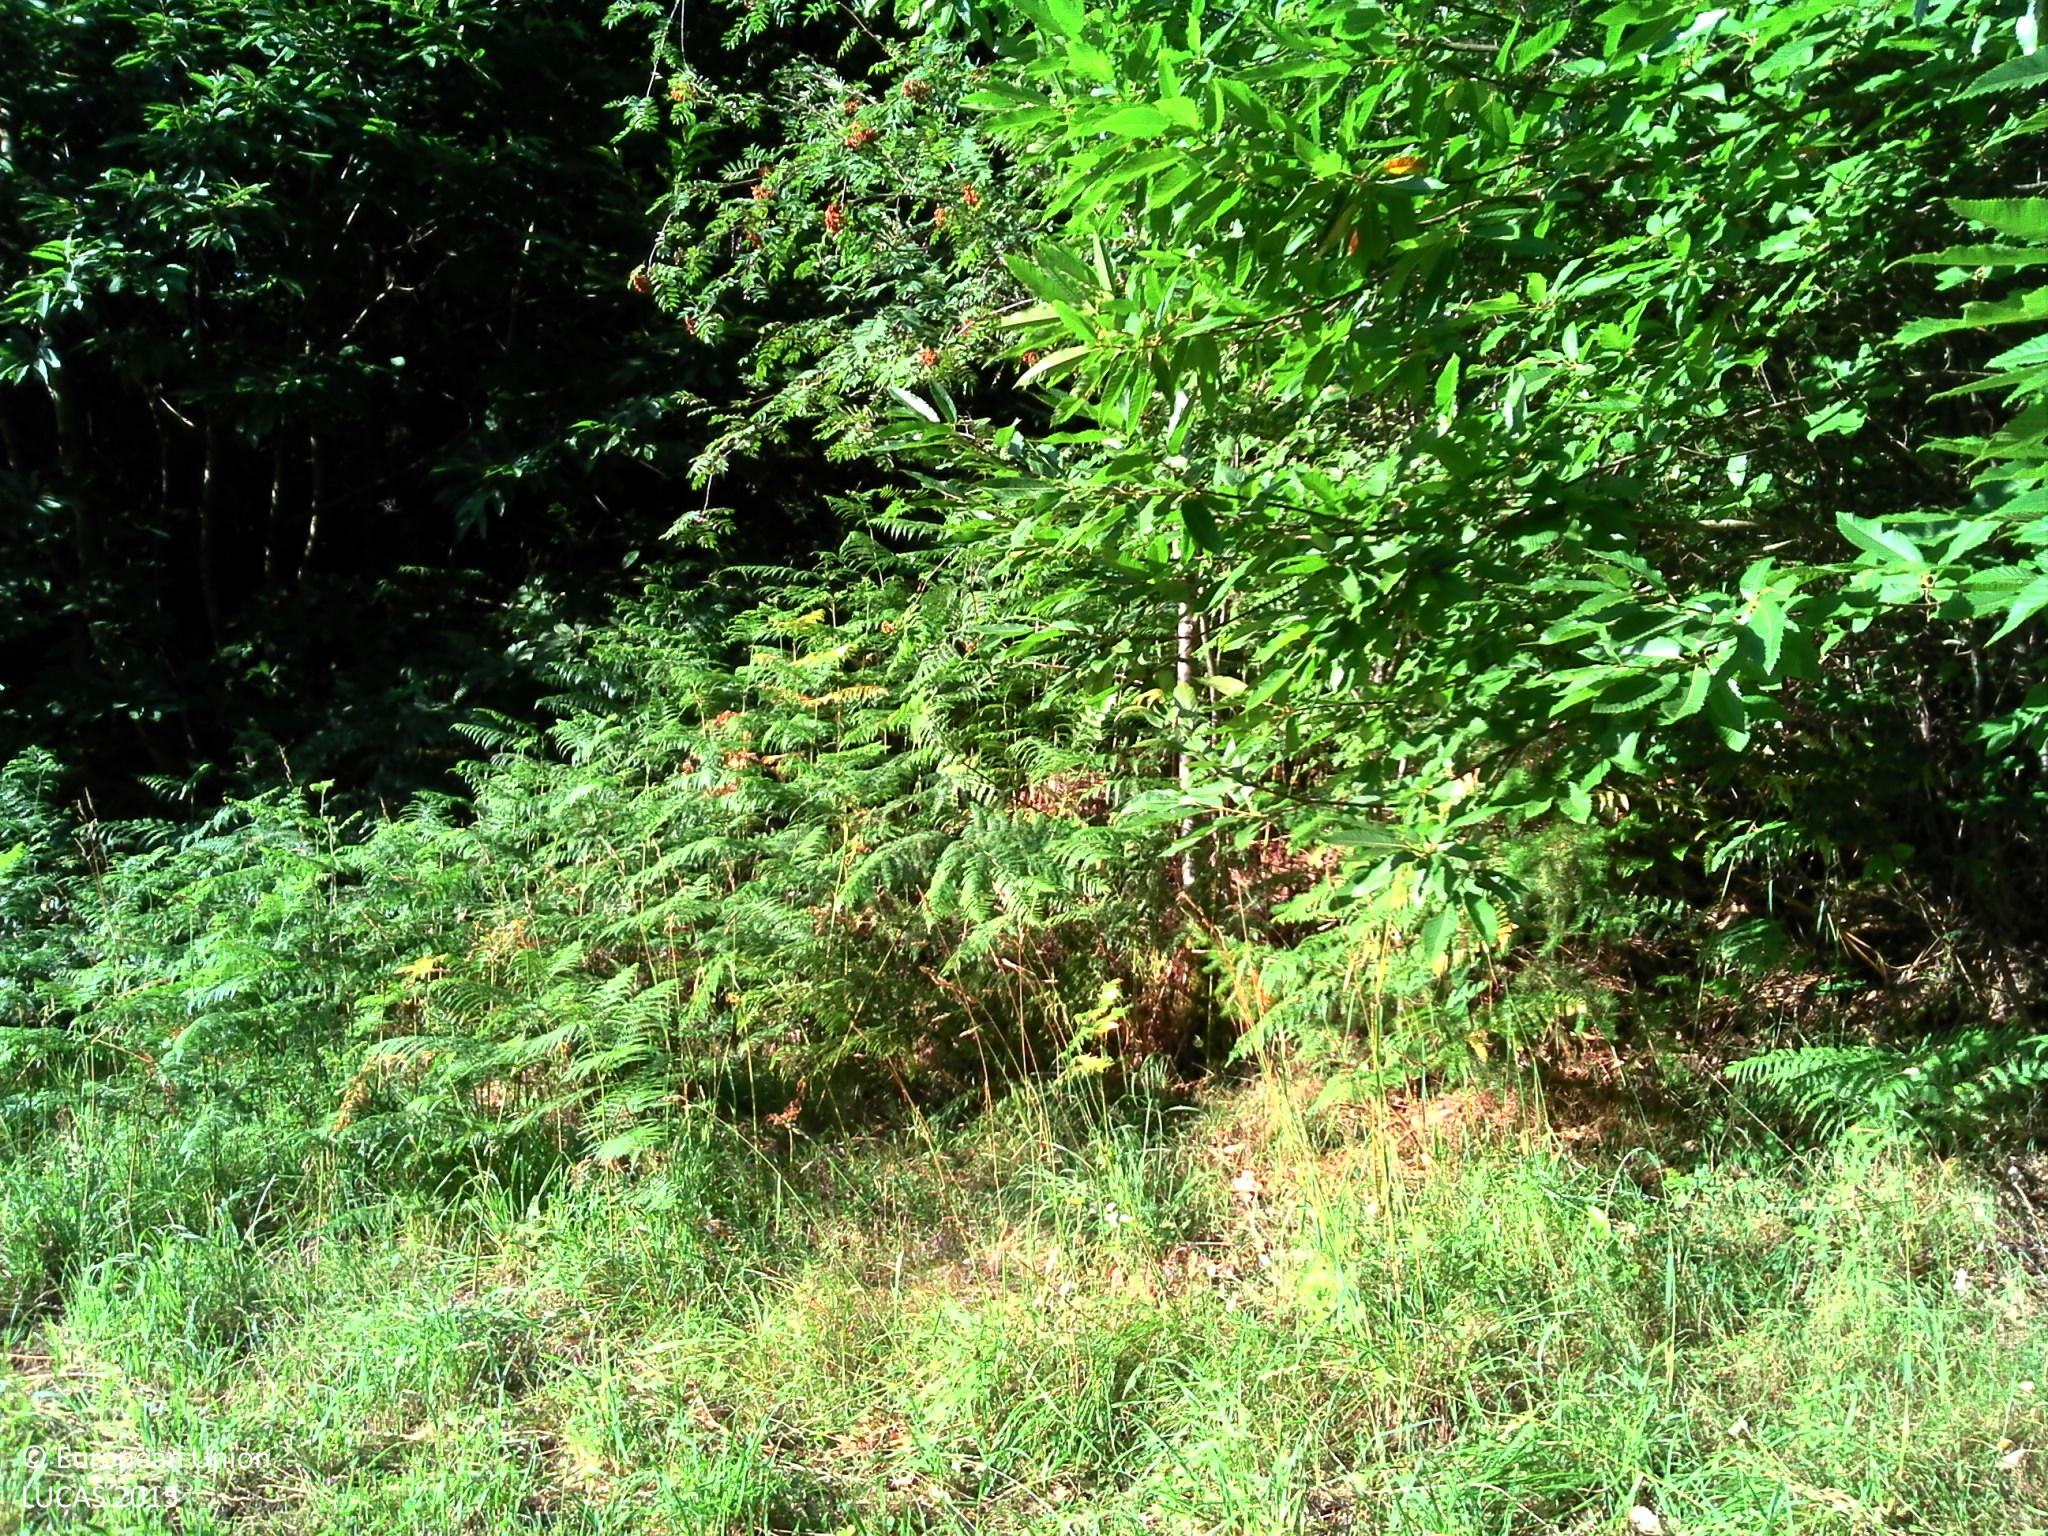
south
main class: Cropland
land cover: Temporary grasslands
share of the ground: > 75 %
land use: Agriculture (excluding fallow land and kitchen gardens)
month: July
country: FR
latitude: 45.7289
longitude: 1.8091
